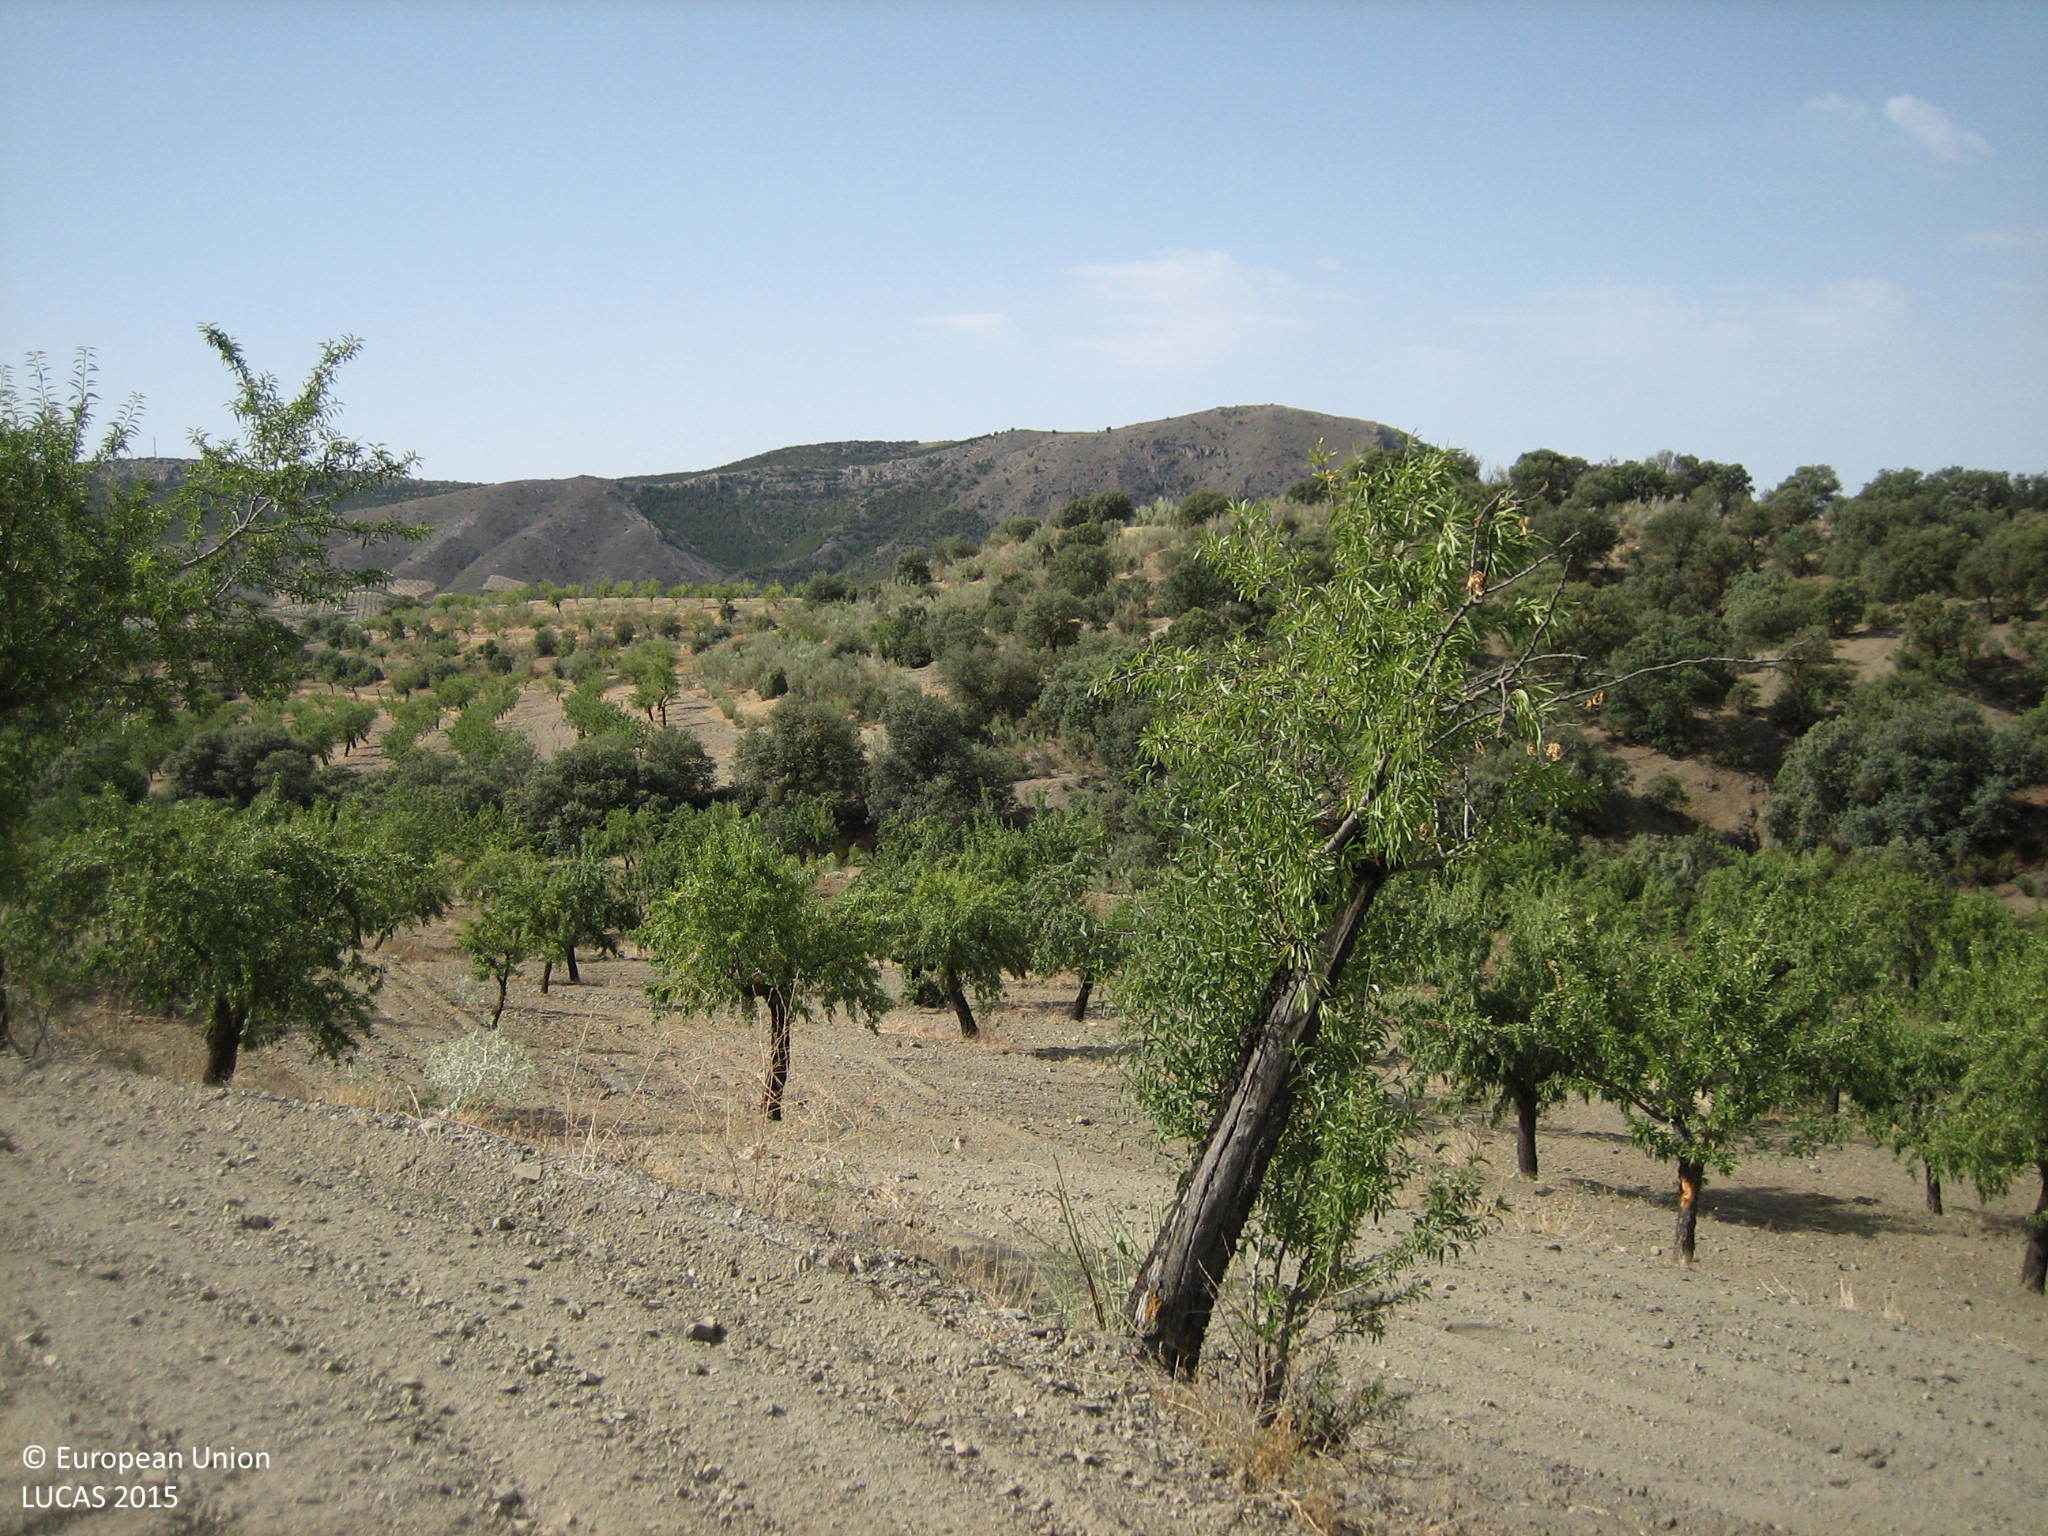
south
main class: Cropland
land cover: Nuts trees
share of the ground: 10 - 25 %
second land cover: Other bare soil
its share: > 75 %
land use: Agriculture (excluding fallow land and kitchen gardens)
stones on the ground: < 10 %
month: July
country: ES
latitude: 37.5398
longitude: -2.2409
